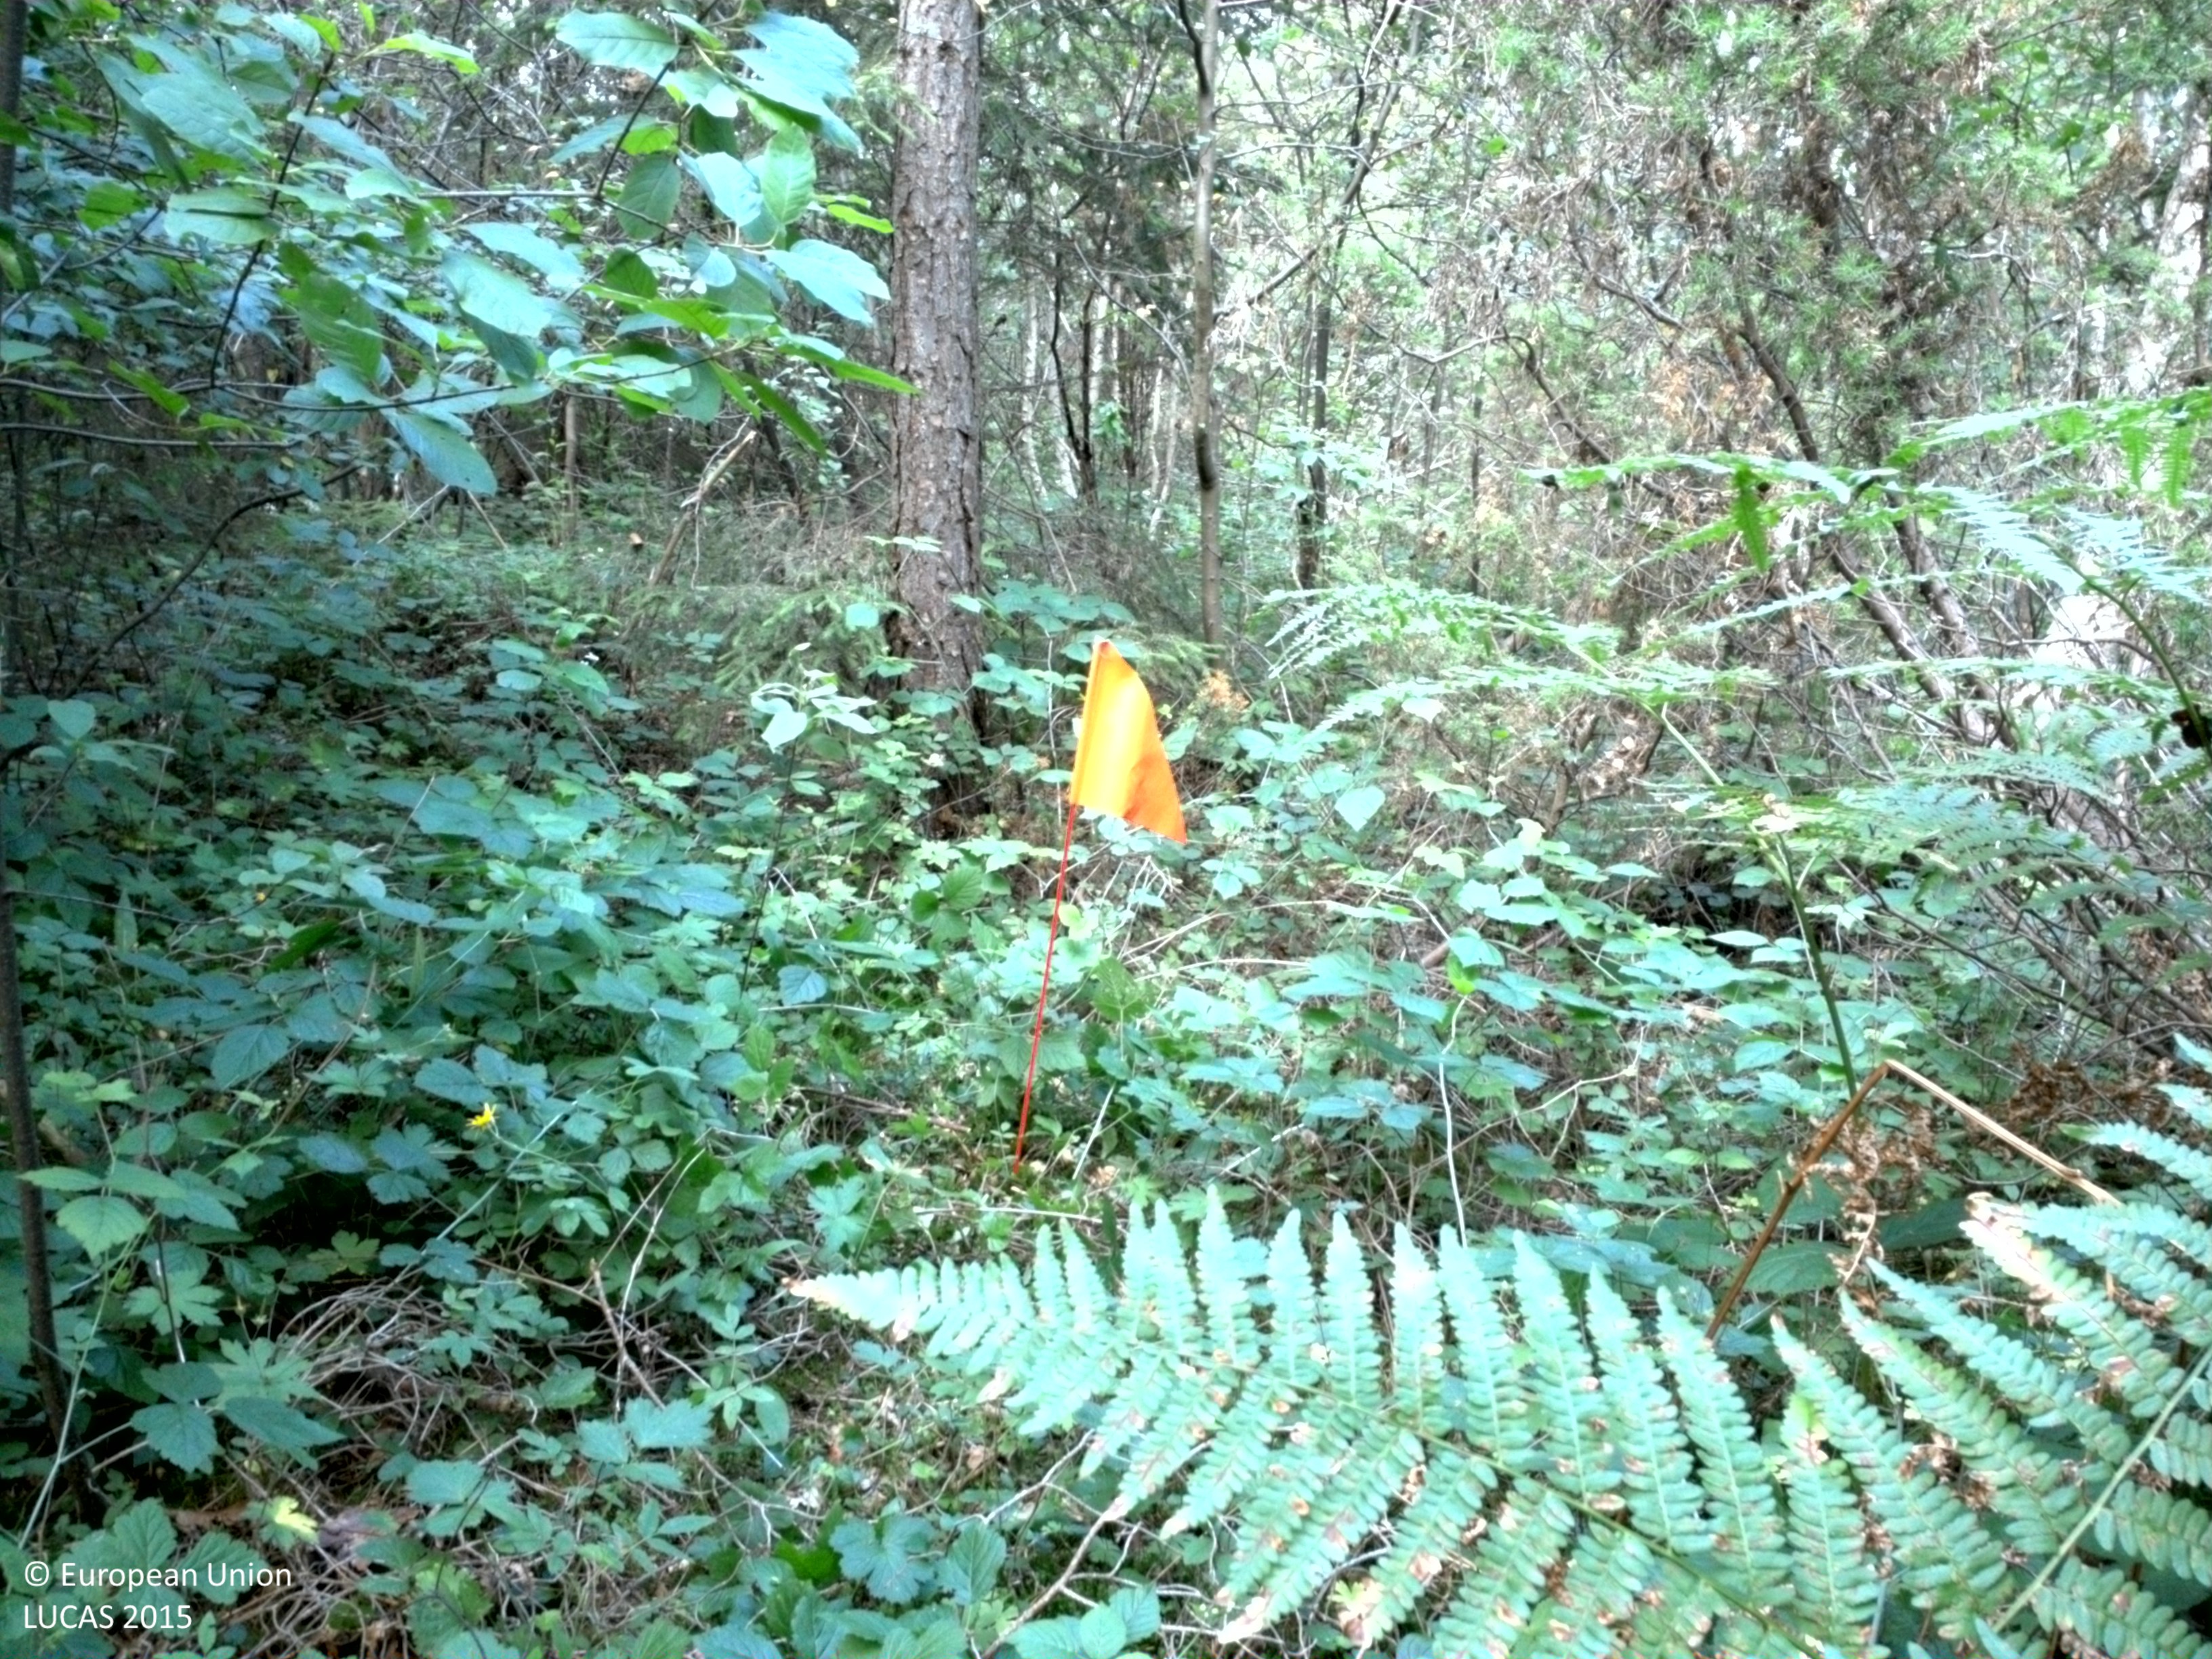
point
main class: Woodland
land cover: Pine dominated mixed woodland
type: hemiboreal forest and nemoral coniferous forest and mixed broadleaved-coniferous forest
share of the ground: > 75 %
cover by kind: coniferous forest trees 60 %, broadleaved forest trees 20 %, herbaceous plants 15 %, shrubs 5 %
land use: Forestry
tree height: > 5 m
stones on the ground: < 10 %
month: July
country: SE
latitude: 57.5458
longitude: 18.3112
